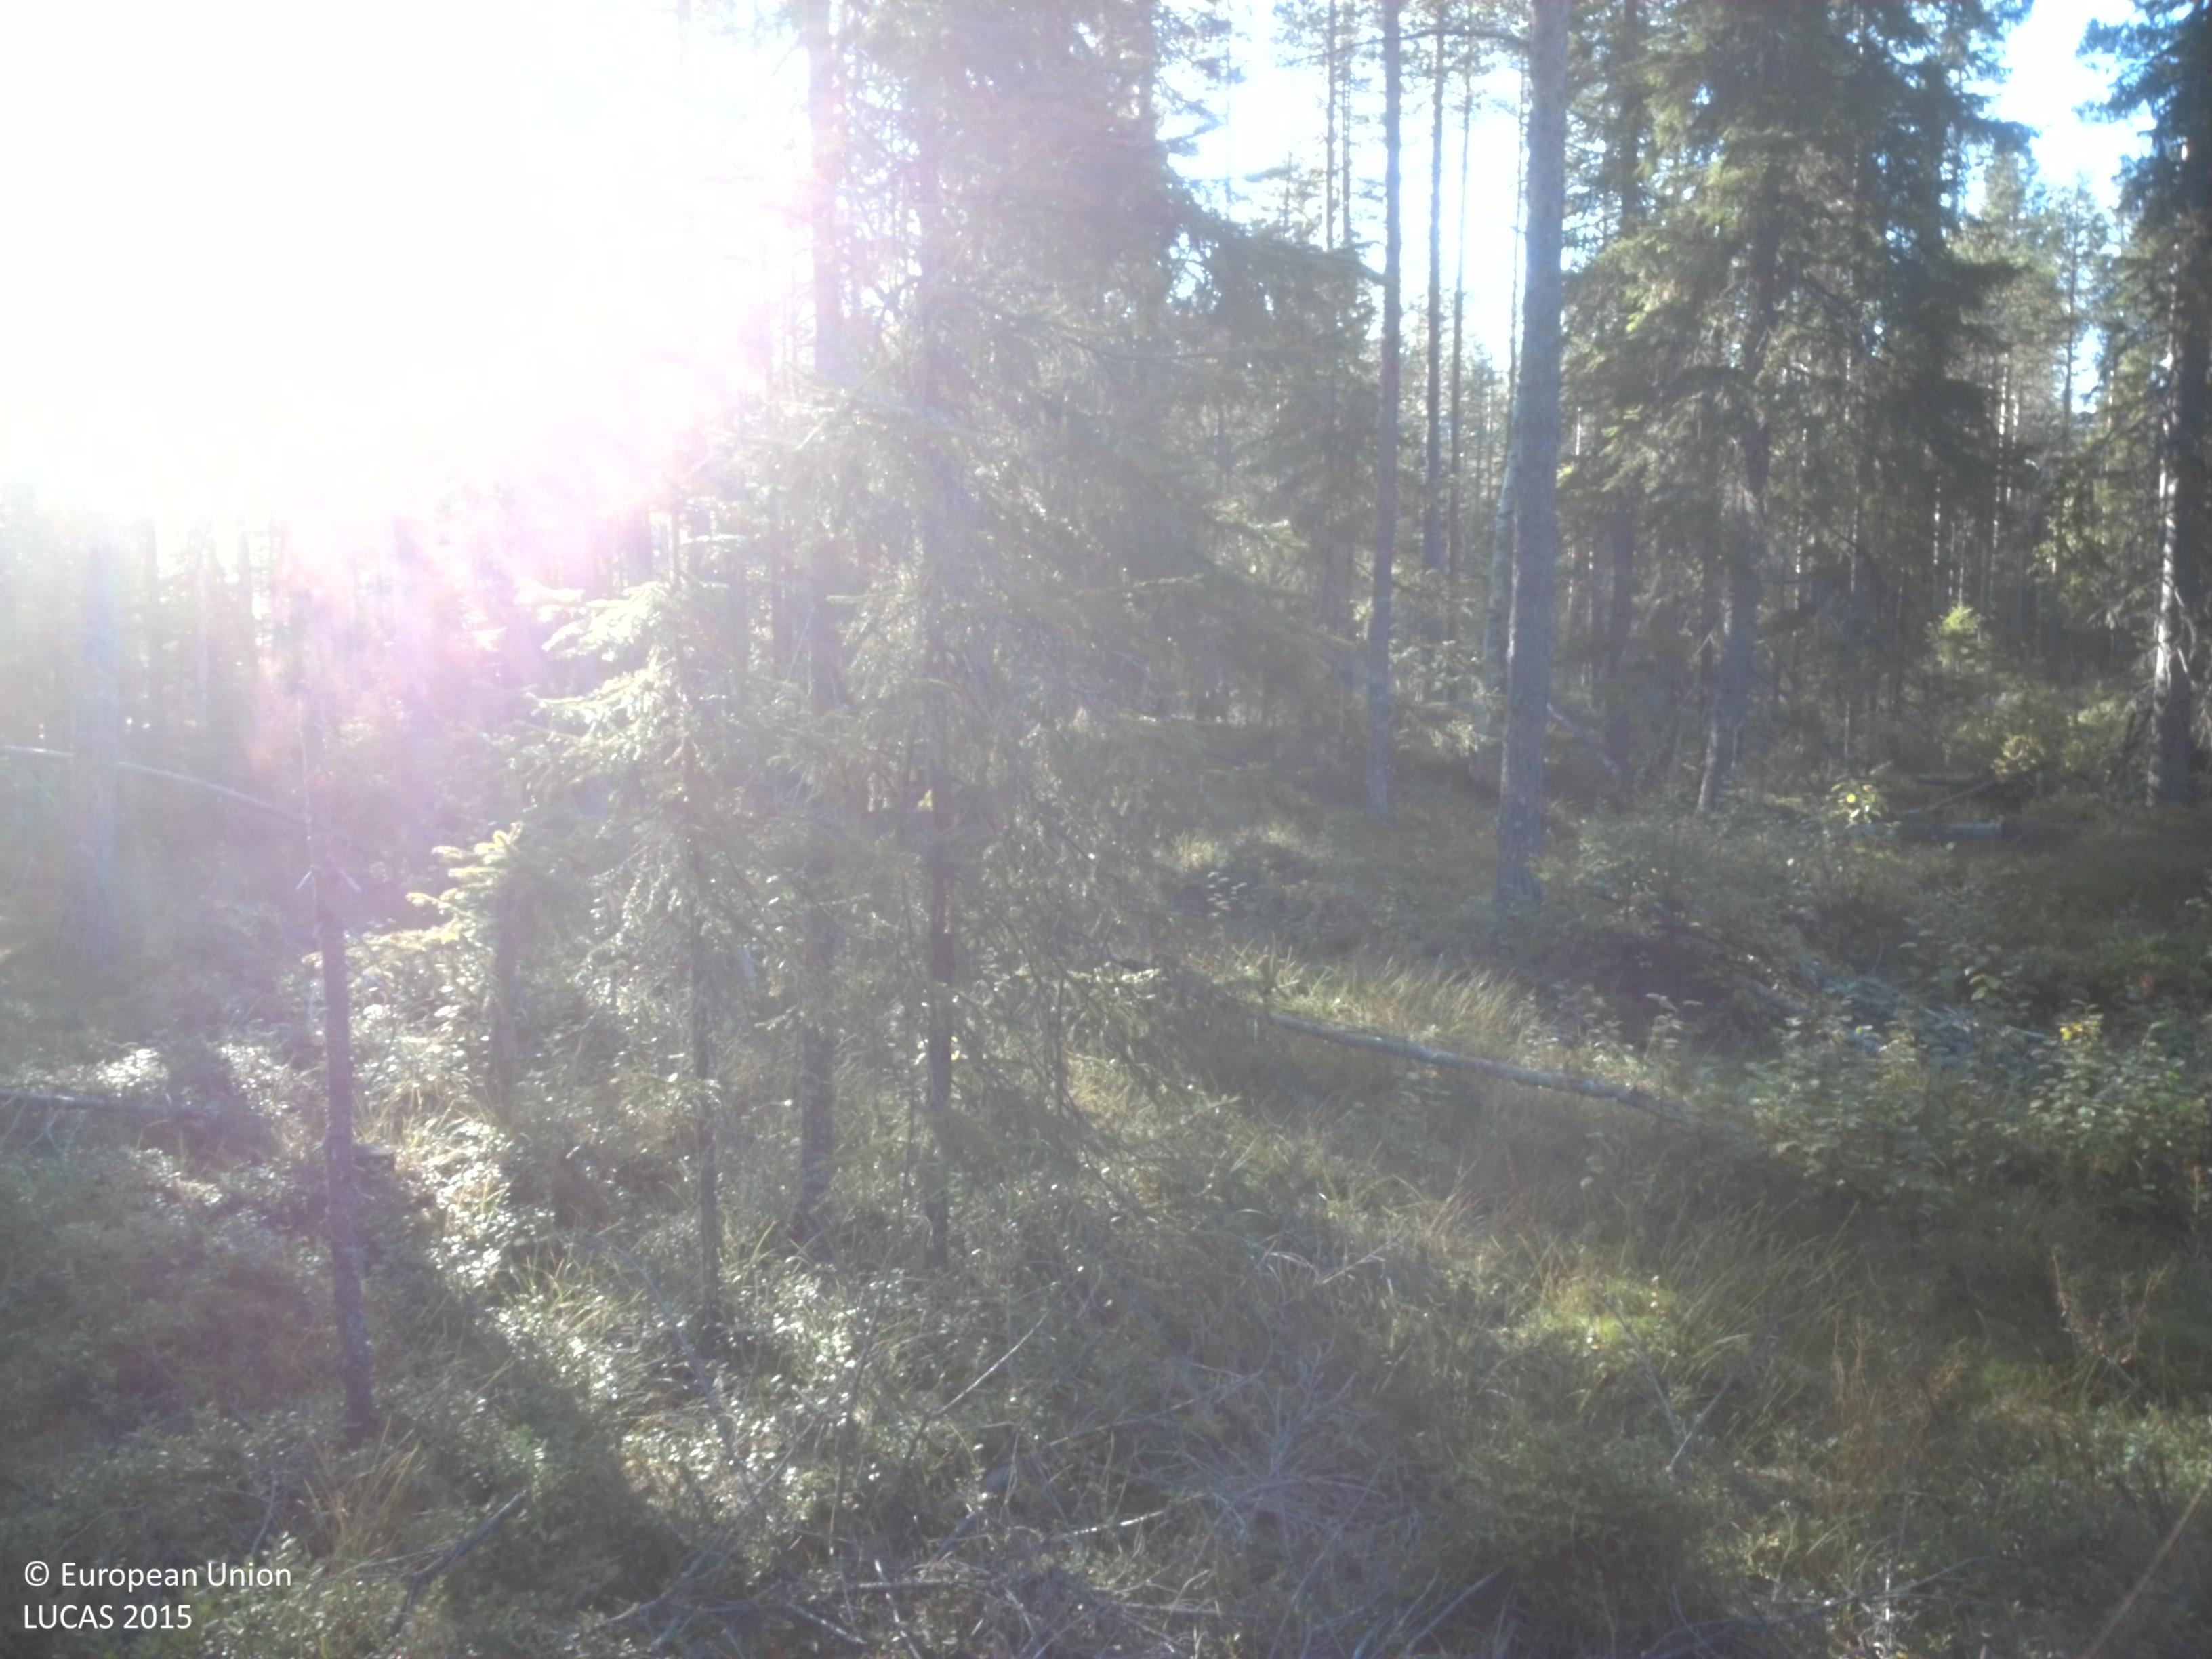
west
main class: Woodland
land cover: Other coniferous woodland
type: boreal forest
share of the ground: 50 - 75 %
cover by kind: coniferous forest trees 45 %, shrubs 35 %, lichens and mosses 10 %, broadleaved forest trees 5 %, herbaceous plants 5 %
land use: Forestry
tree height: > 5 m
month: September
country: SE
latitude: 64.6778
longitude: 19.7991
